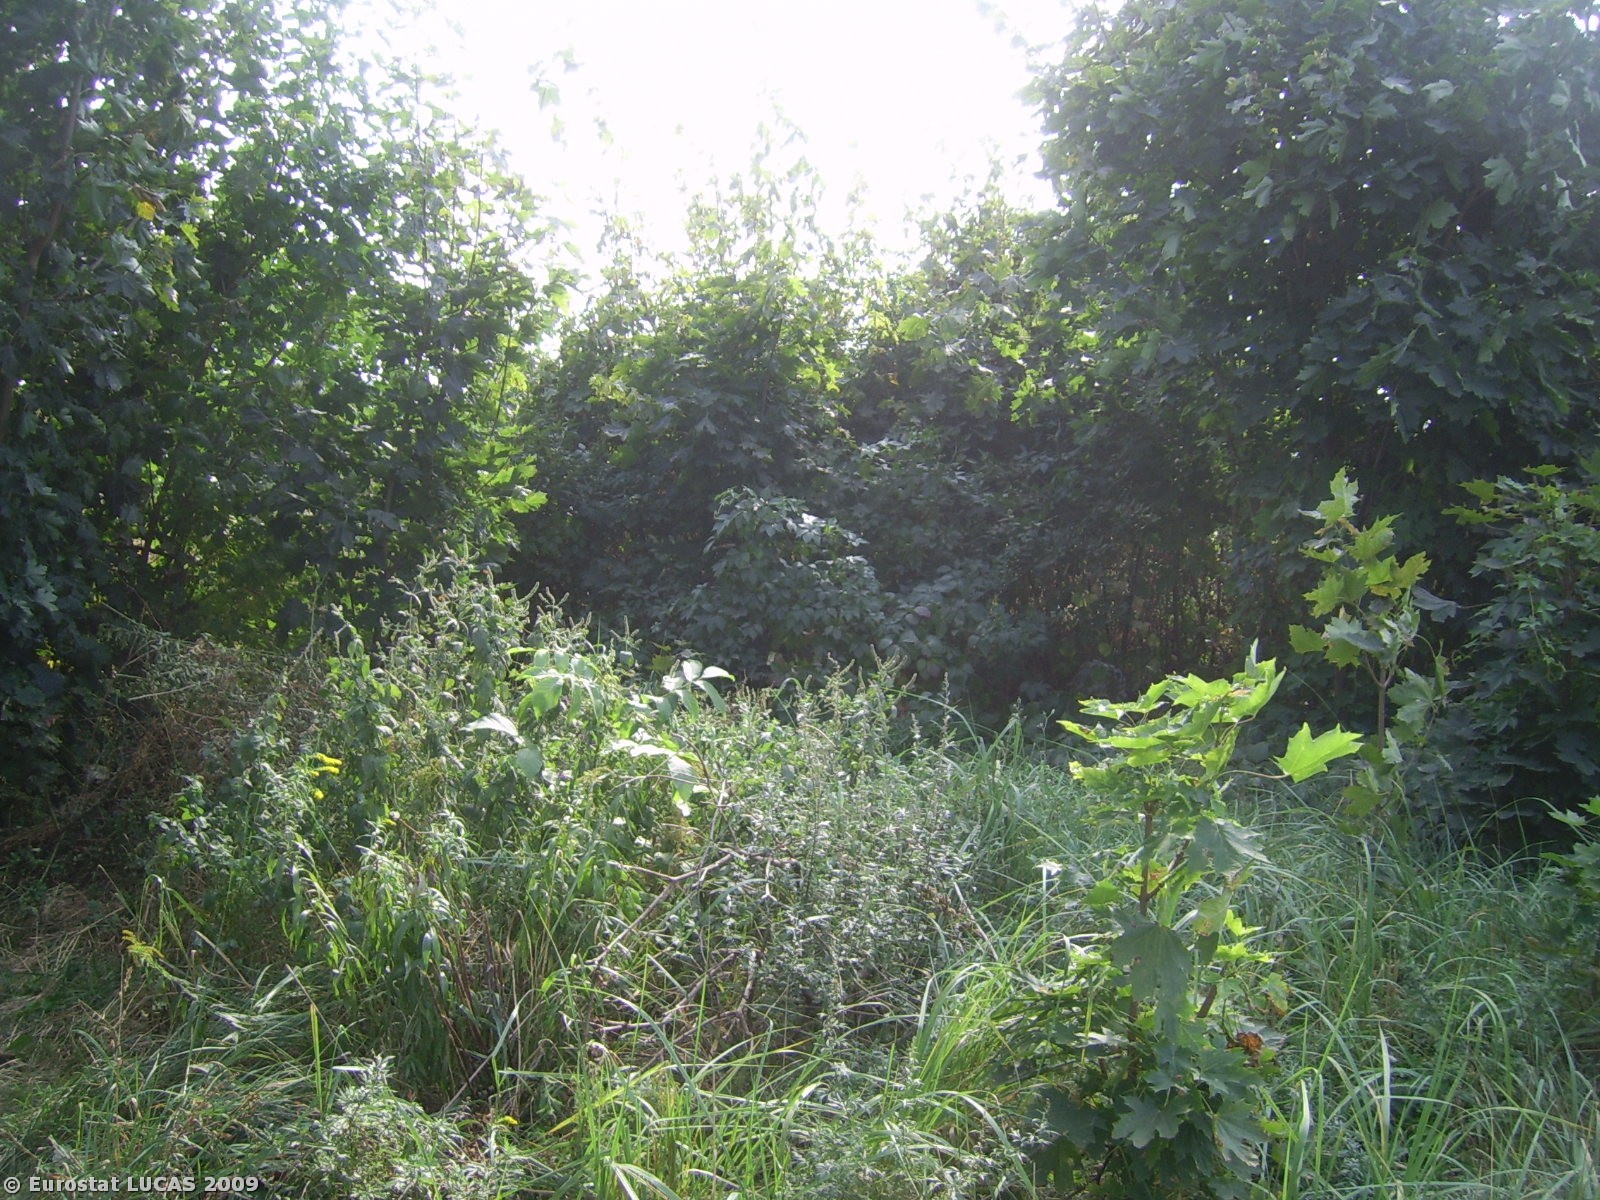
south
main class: Cropland
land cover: Floriculture and ornamental plants
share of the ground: 50 - 75 %
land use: Amenities, museums, leisure
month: September
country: PL
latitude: 52.3718
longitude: 16.9571
